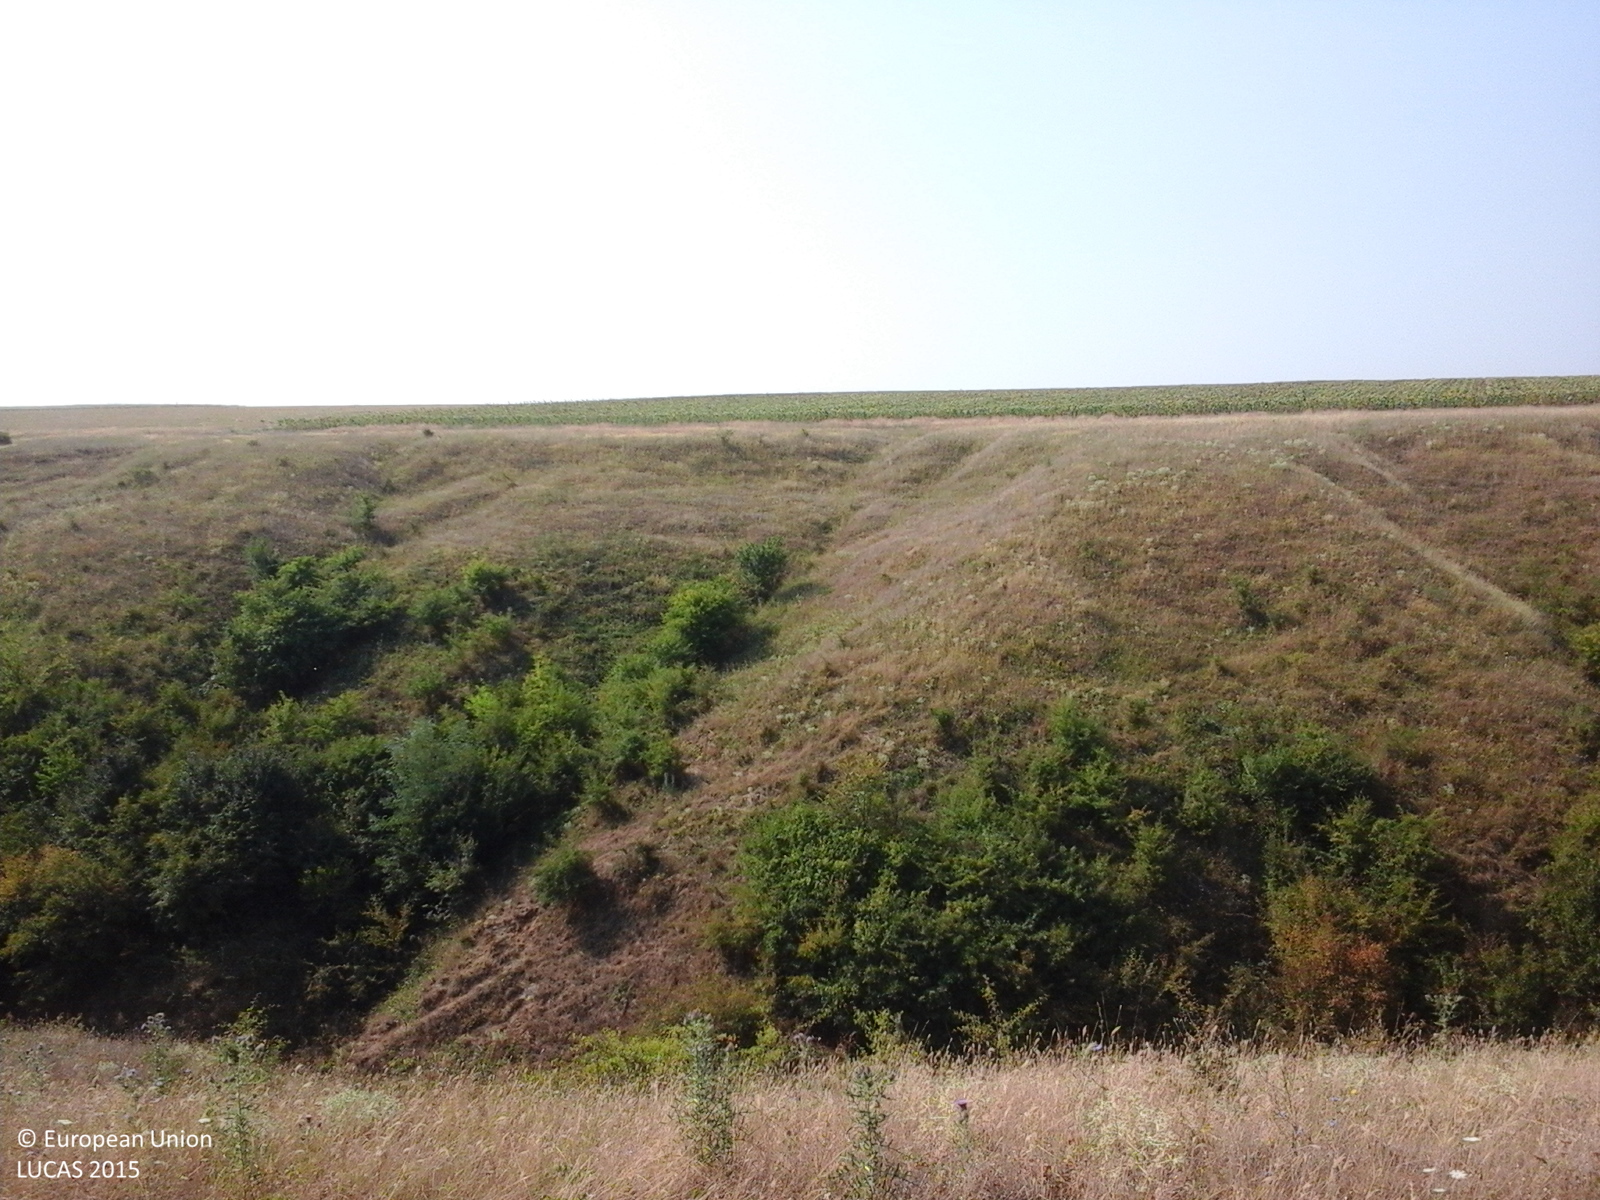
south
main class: Grassland
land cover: Grassland without tree/shrub cover
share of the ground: > 75 %
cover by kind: herbaceous plants 100 %
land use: Agriculture (excluding fallow land and kitchen gardens)
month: August
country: RO
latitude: 44.4403
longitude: 23.1517
